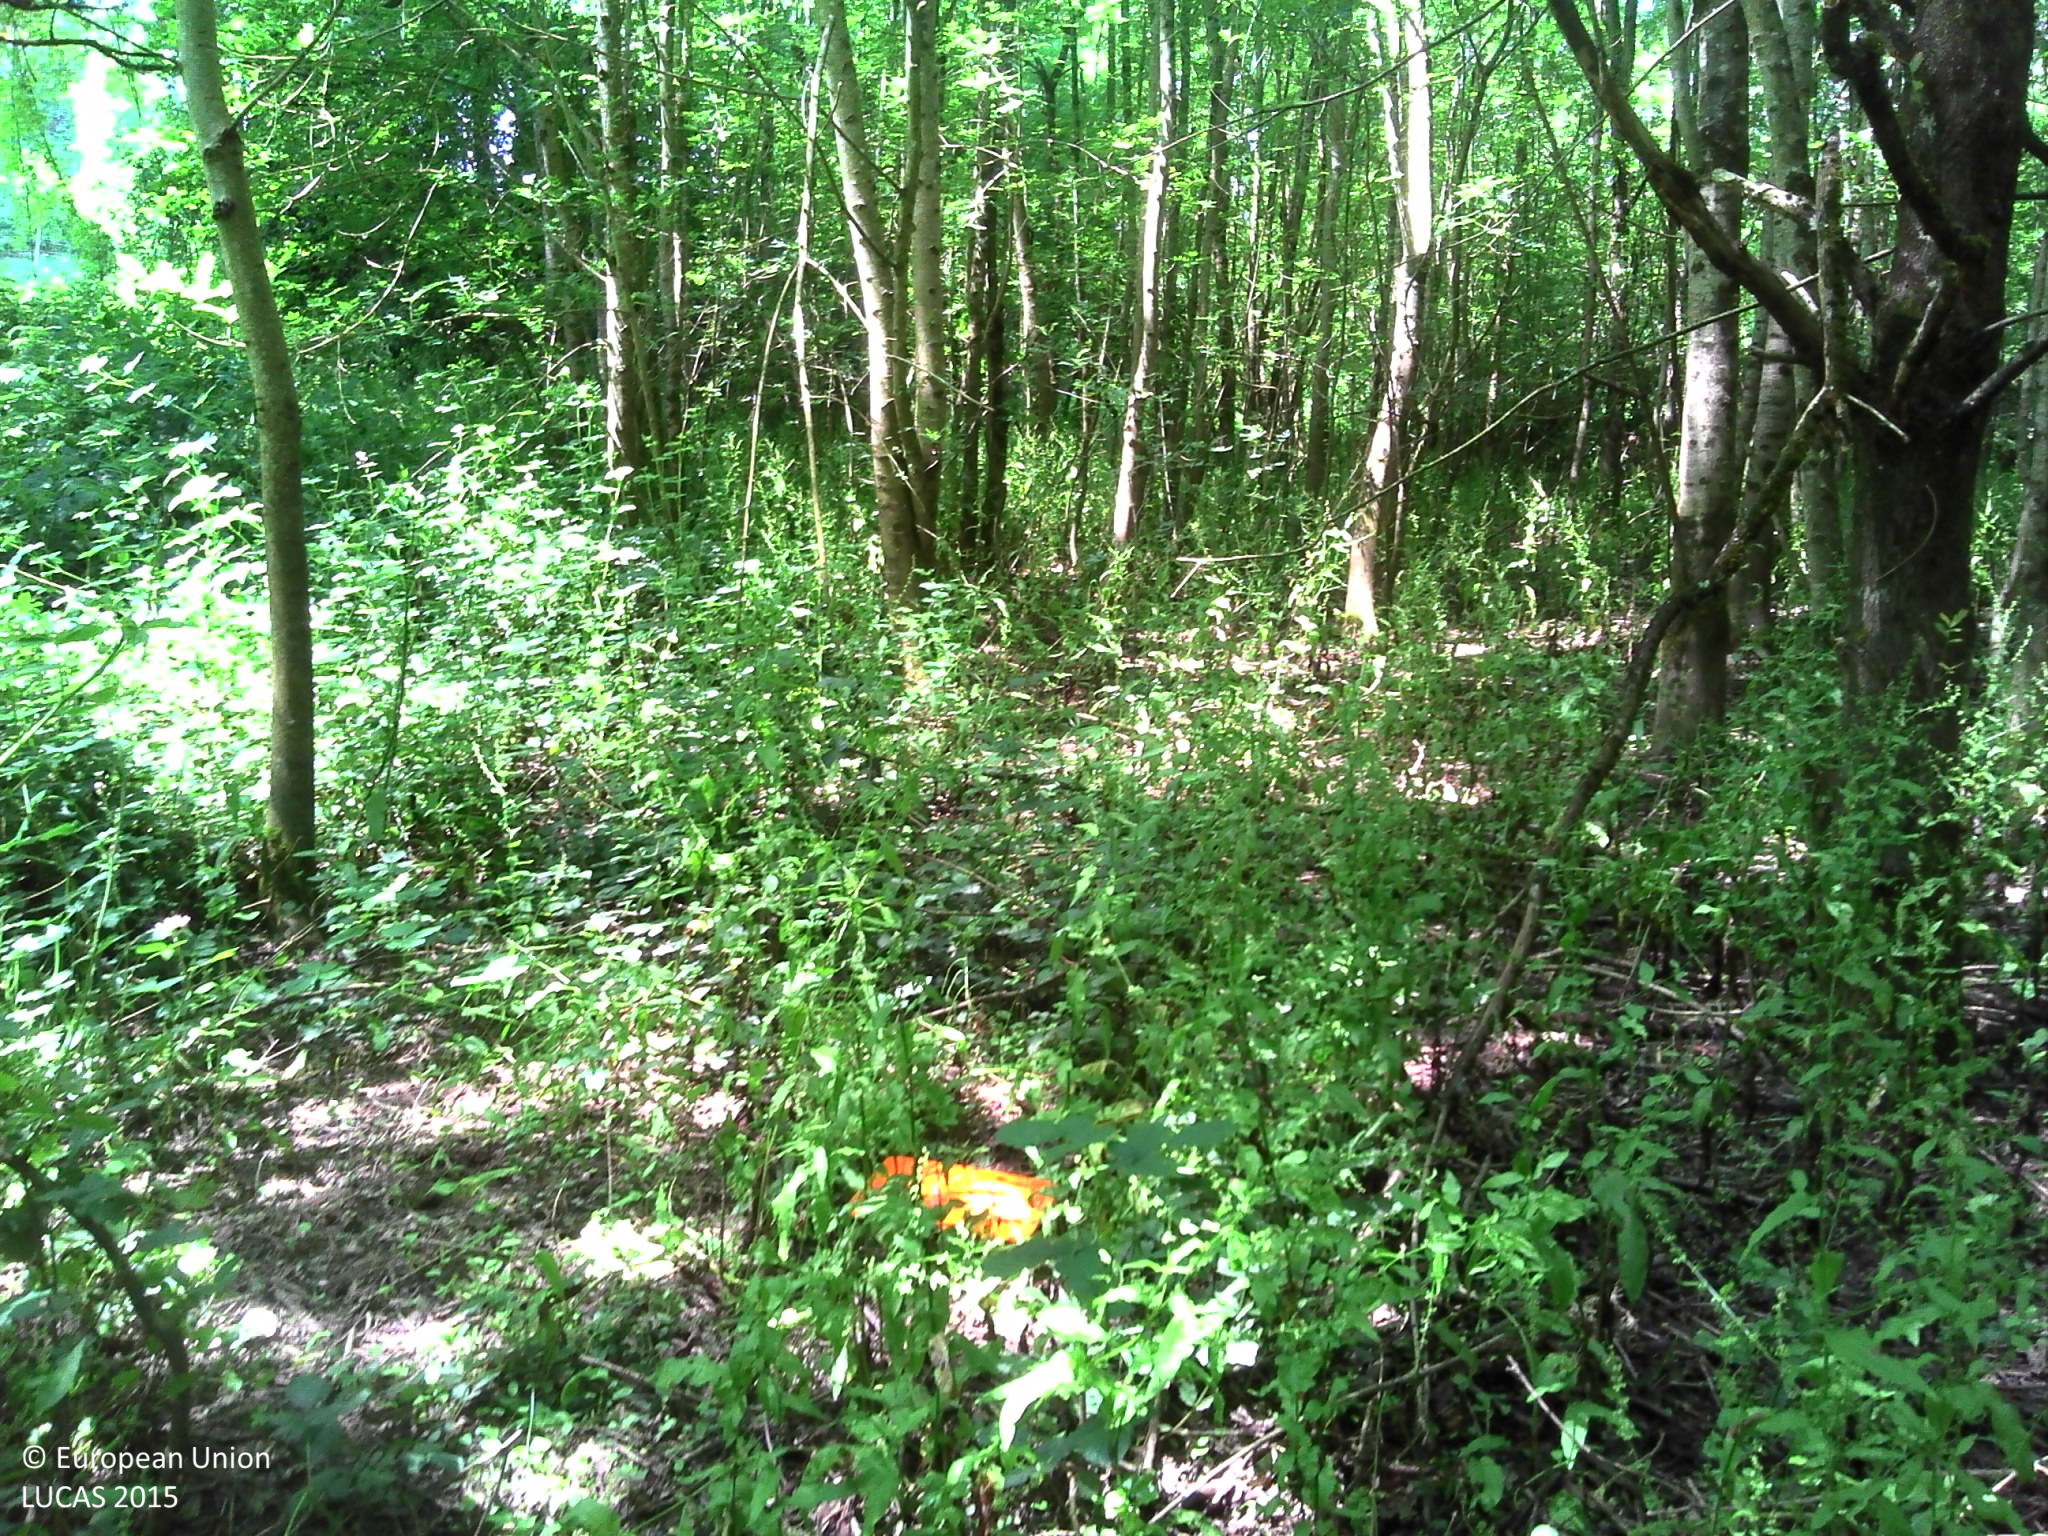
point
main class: Woodland
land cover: Broadleaved woodland
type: floodplain forest
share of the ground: > 75 %
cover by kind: broadleaved forest trees 95 %, herbaceous plants 5 %
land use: Semi-natural and natural areas not in use
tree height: > 5 m
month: June
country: FR
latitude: 47.1374
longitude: -1.4186
